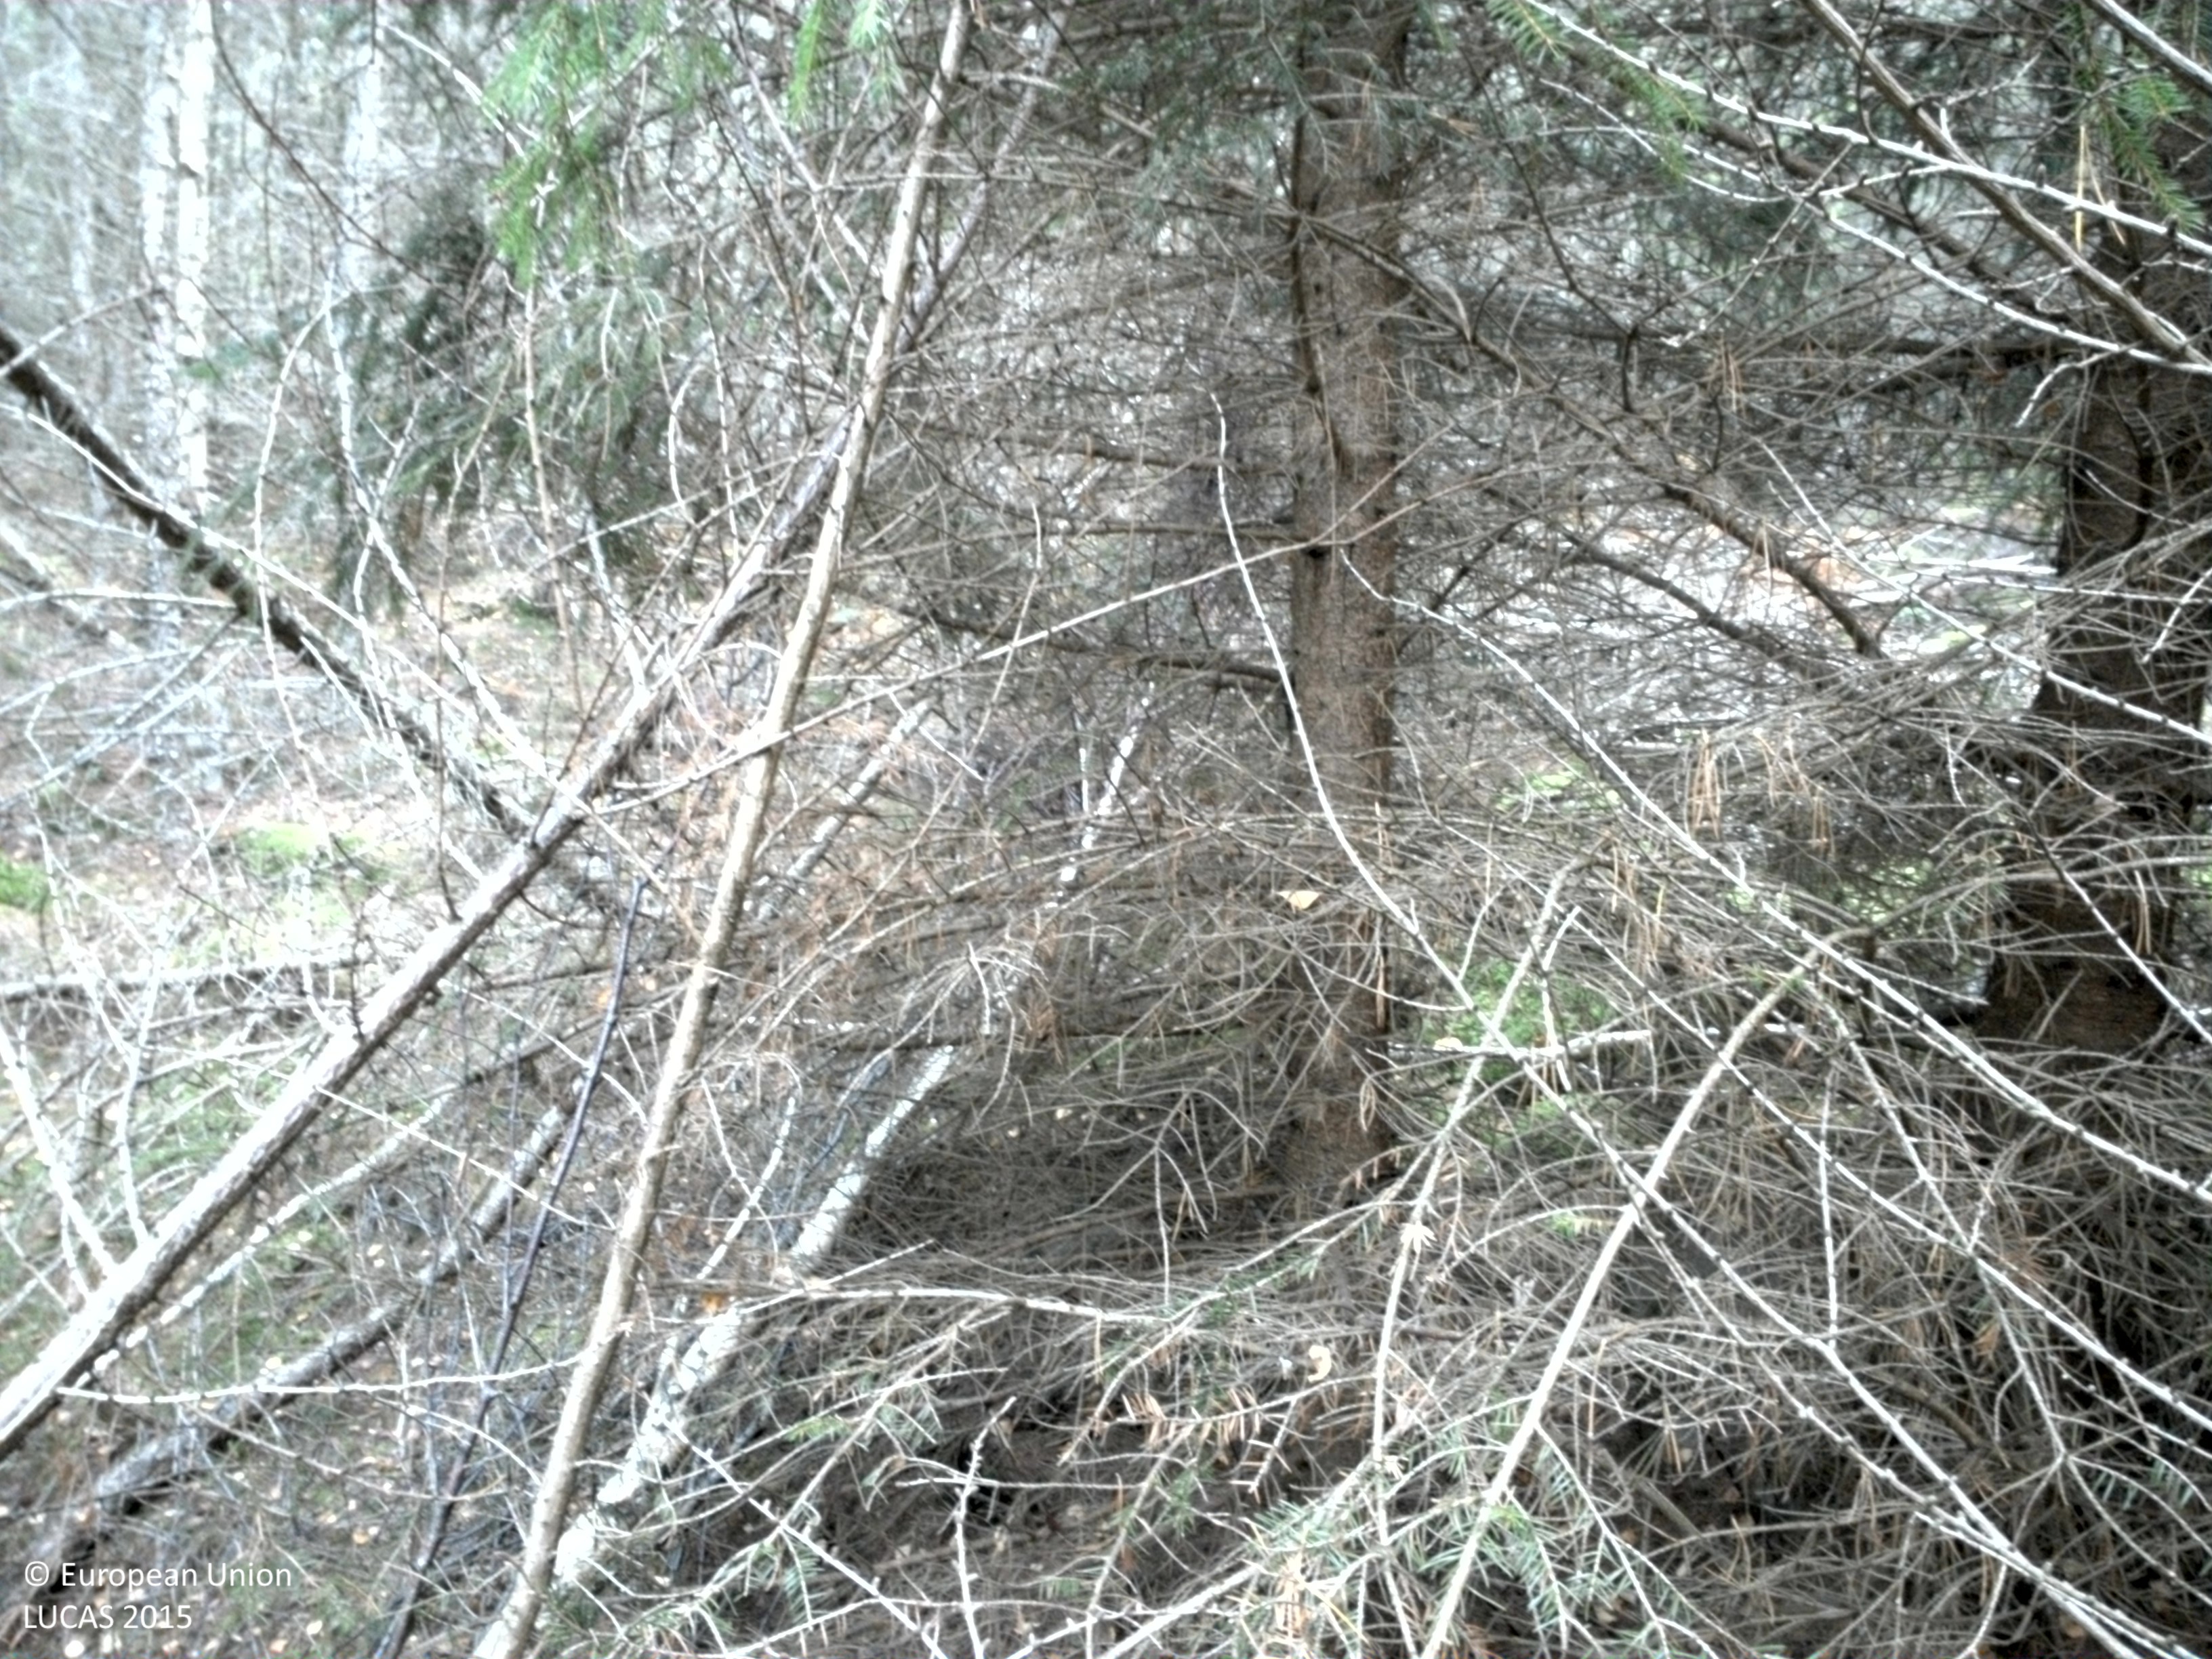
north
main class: Woodland
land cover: Other coniferous woodland
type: boreal forest
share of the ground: 50 - 75 %
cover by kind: coniferous forest trees 60 %, shrubs 10 %, lichens and mosses 10 %, unconsolidated bare surface 10 %, broadleaved forest trees 5 %, herbaceous plants 5 %
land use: Forestry
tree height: > 5 m
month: October
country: SE
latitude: 58.0953
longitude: 13.0316
